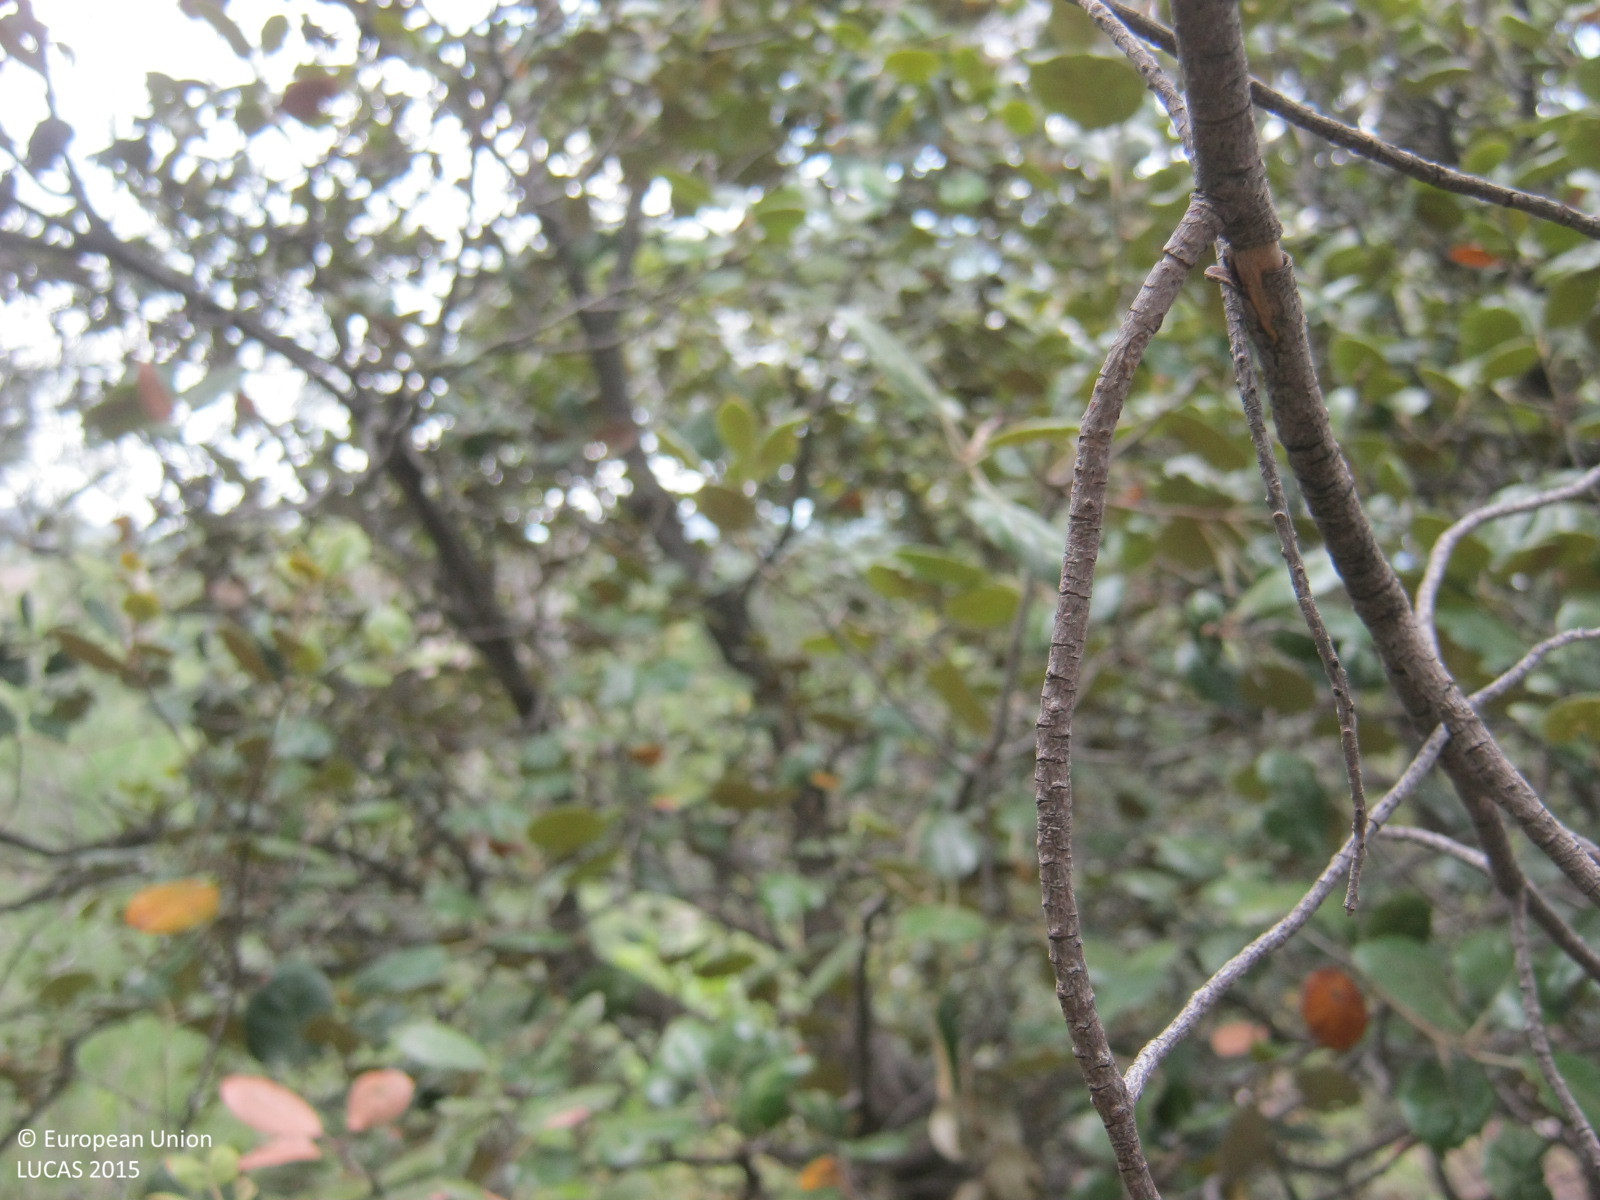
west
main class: Woodland
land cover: Pine dominated mixed woodland
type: coniferous forest of the mediterranean region
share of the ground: > 75 %
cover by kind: coniferous forest trees 45 %, broadleaved forest trees 30 %, unconsolidated bare surface 15 %, shrubs 10 %
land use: Forestry
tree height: > 5 m
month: June
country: CY
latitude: 34.9812
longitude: 32.8538
